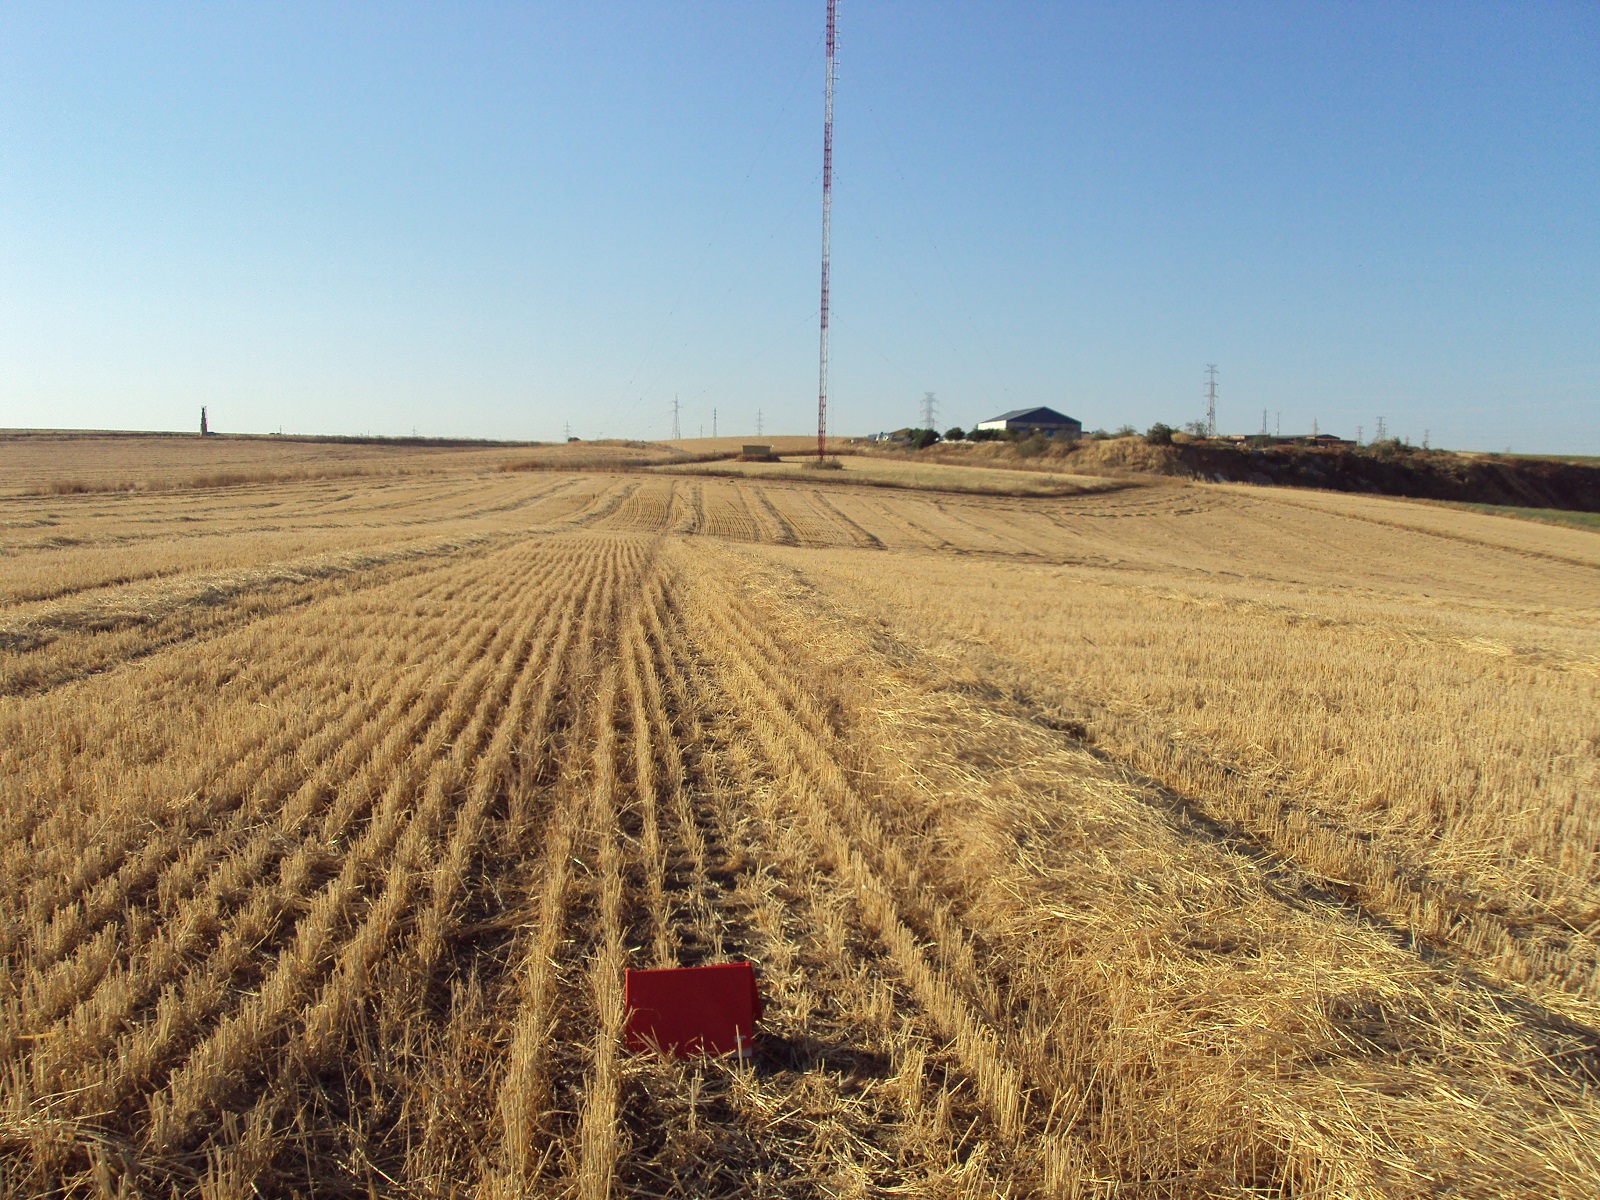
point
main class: Cropland
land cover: Durum wheat
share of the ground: > 75 %
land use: Agriculture (excluding fallow land and kitchen gardens)
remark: Harvested field
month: June
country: ES
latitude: 37.3077
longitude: -6.9290
